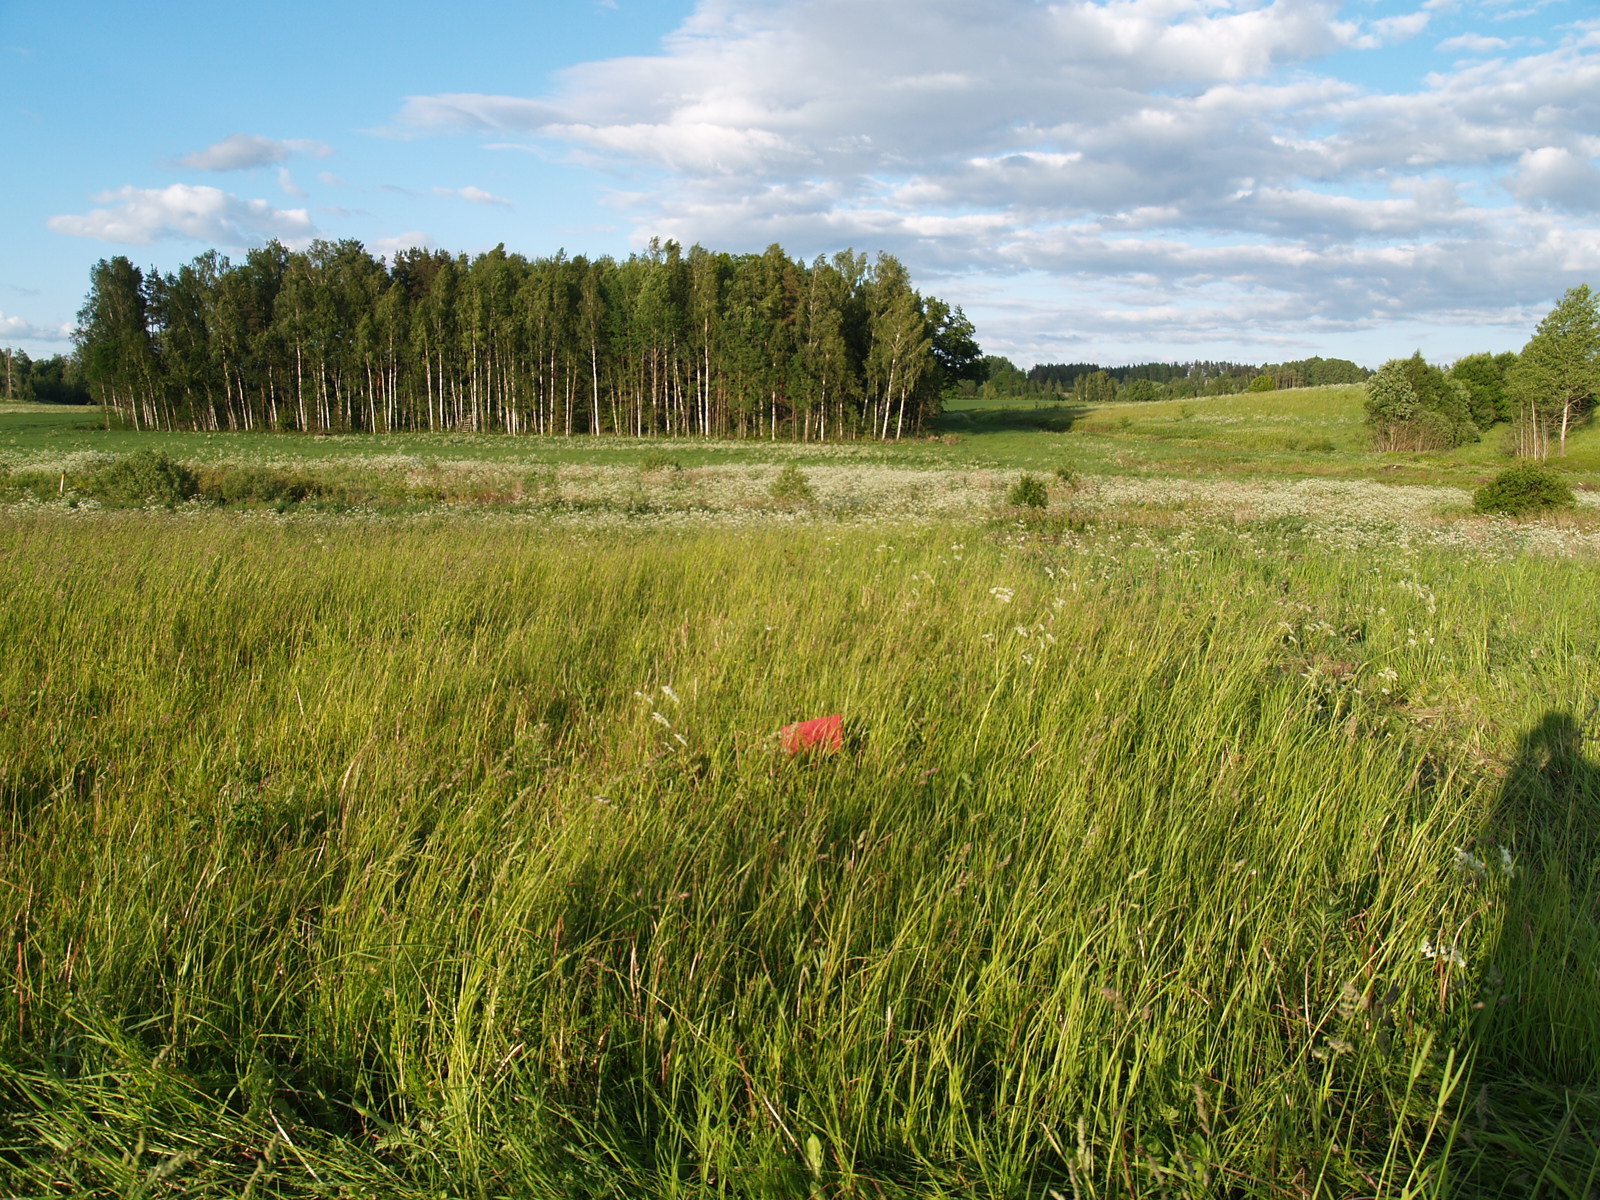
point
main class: Grassland
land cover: Grassland without tree/shrub cover
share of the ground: > 75 %
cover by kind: herbaceous plants 100 %
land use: Agriculture (excluding fallow land and kitchen gardens)
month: June
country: LV
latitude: 56.6488
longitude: 25.6666
